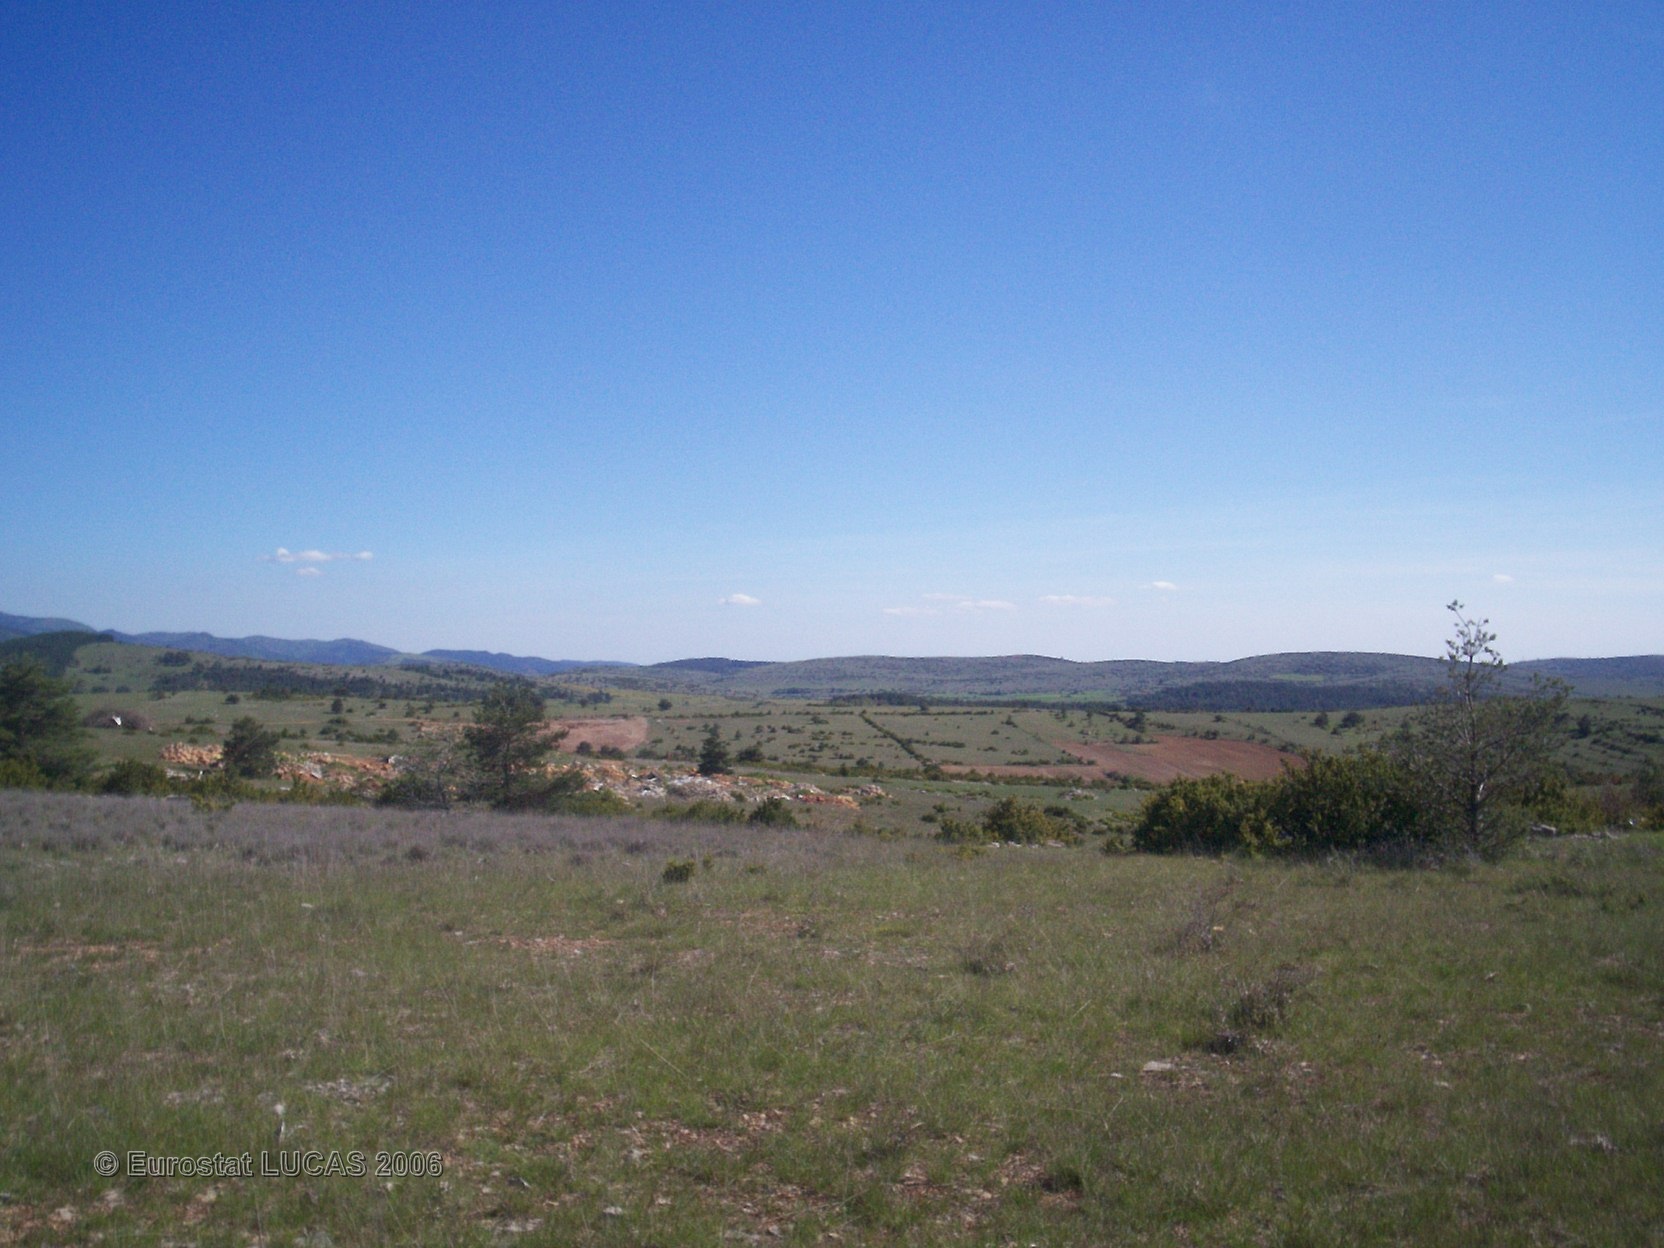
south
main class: Grassland
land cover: Grassland without tree/shrub cover
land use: Agriculture (excluding fallow land and kitchen gardens)
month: May
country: FR
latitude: 44.1384
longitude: 3.3689
